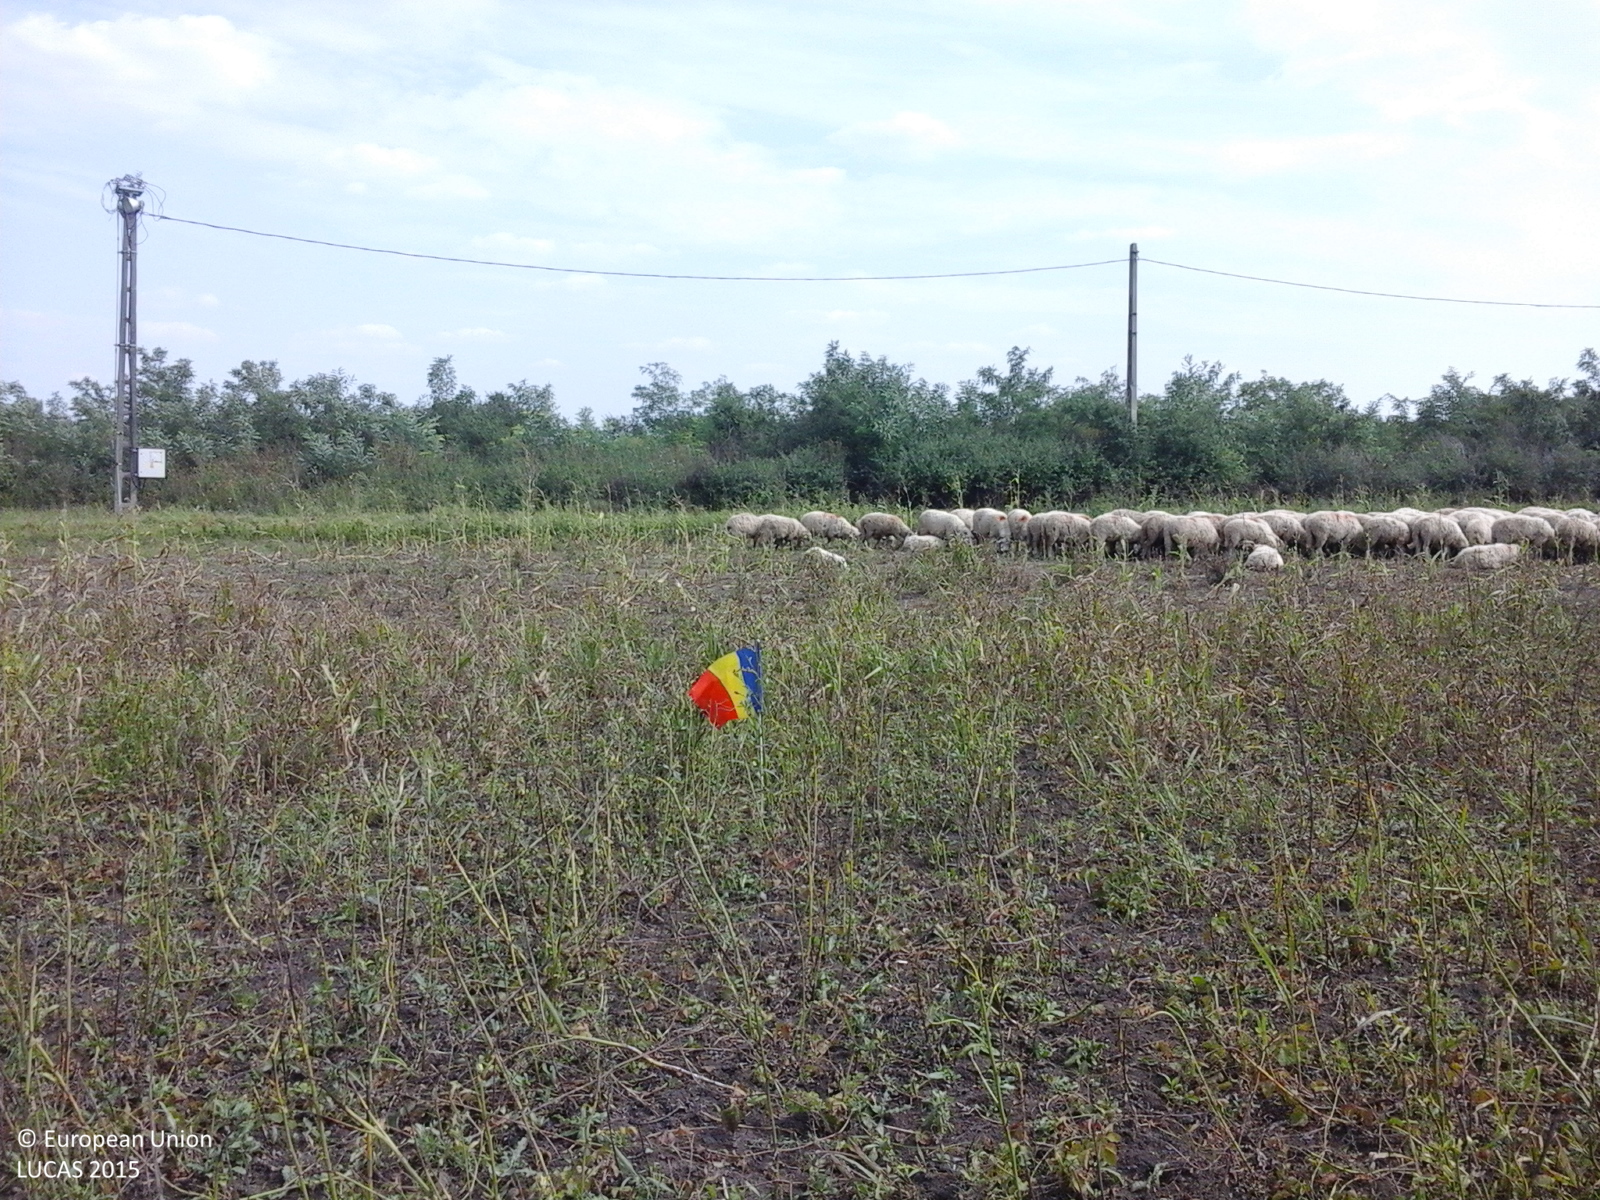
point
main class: Grassland
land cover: Spontaneously vegetated surfaces
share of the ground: > 75 %
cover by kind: herbaceous plants 100 %
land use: Agriculture (excluding fallow land and kitchen gardens)
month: August
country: RO
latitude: 46.2215
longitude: 21.1424
